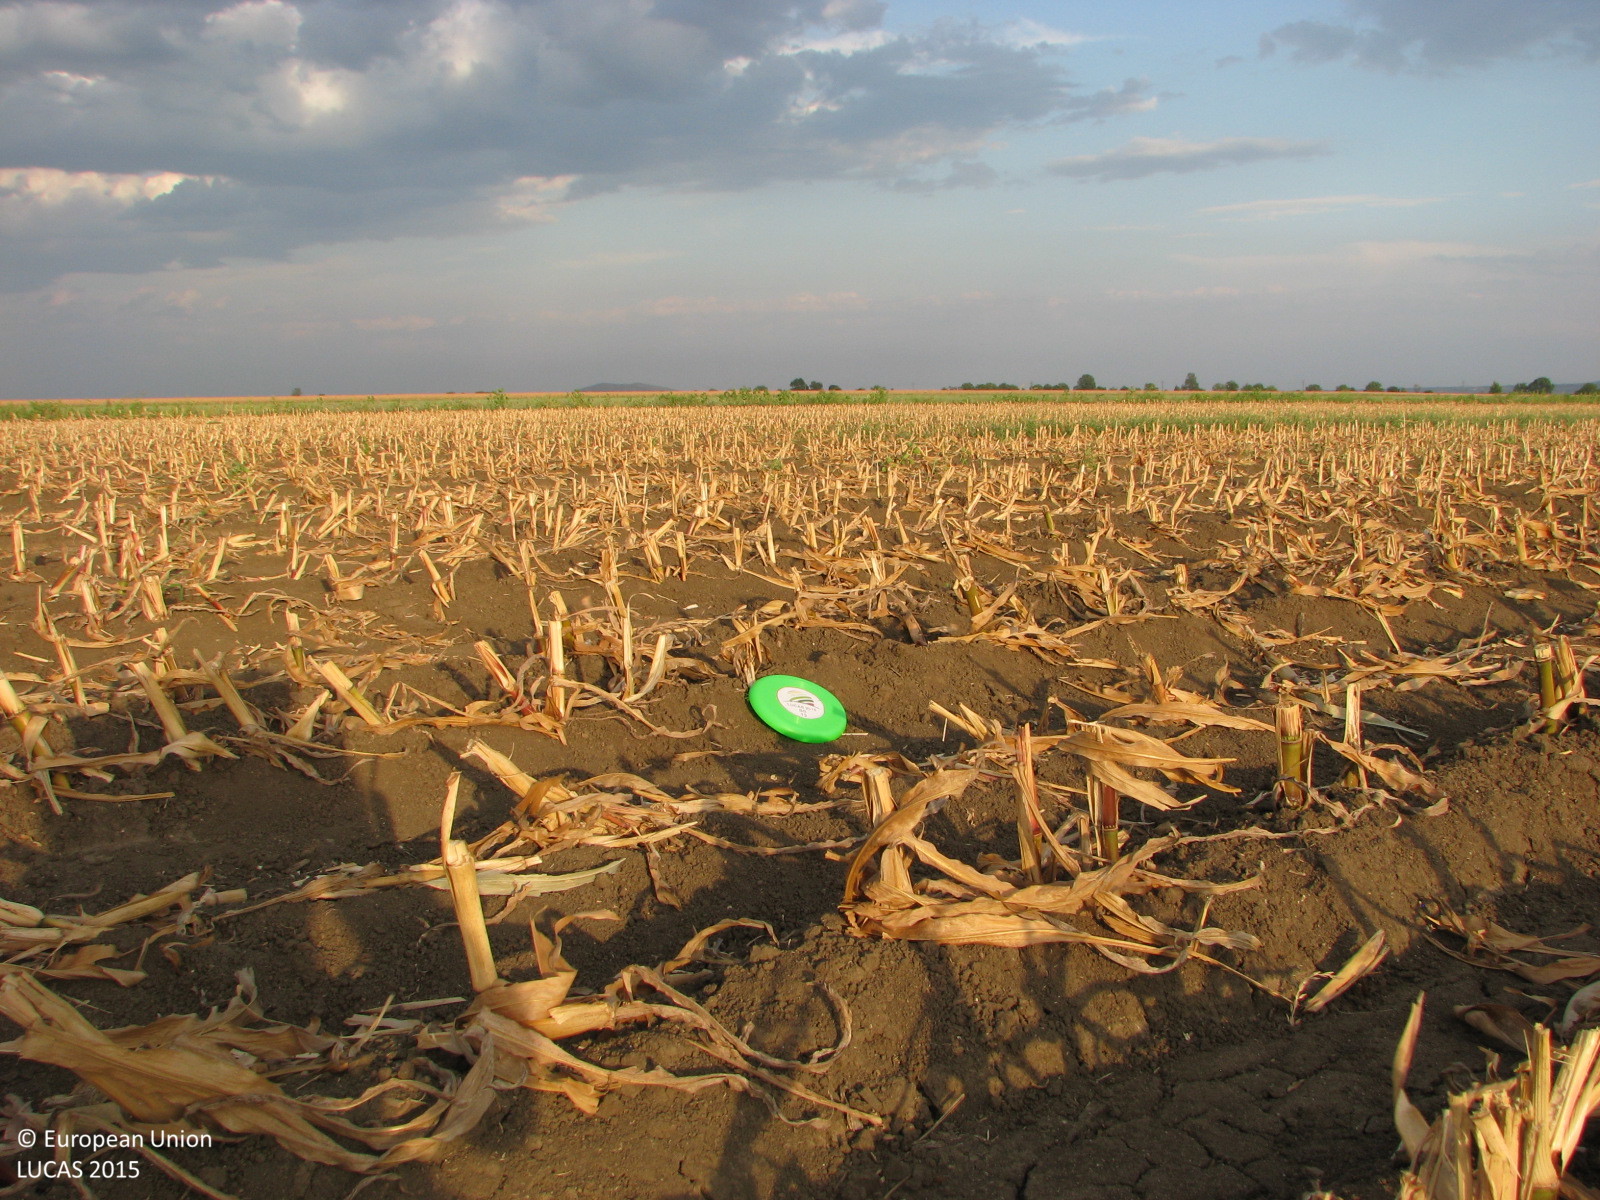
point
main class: Cropland
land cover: Maize
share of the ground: 25 - 50 %
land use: Agriculture (excluding fallow land and kitchen gardens)
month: September
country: BG
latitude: 42.5234
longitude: 26.0409
